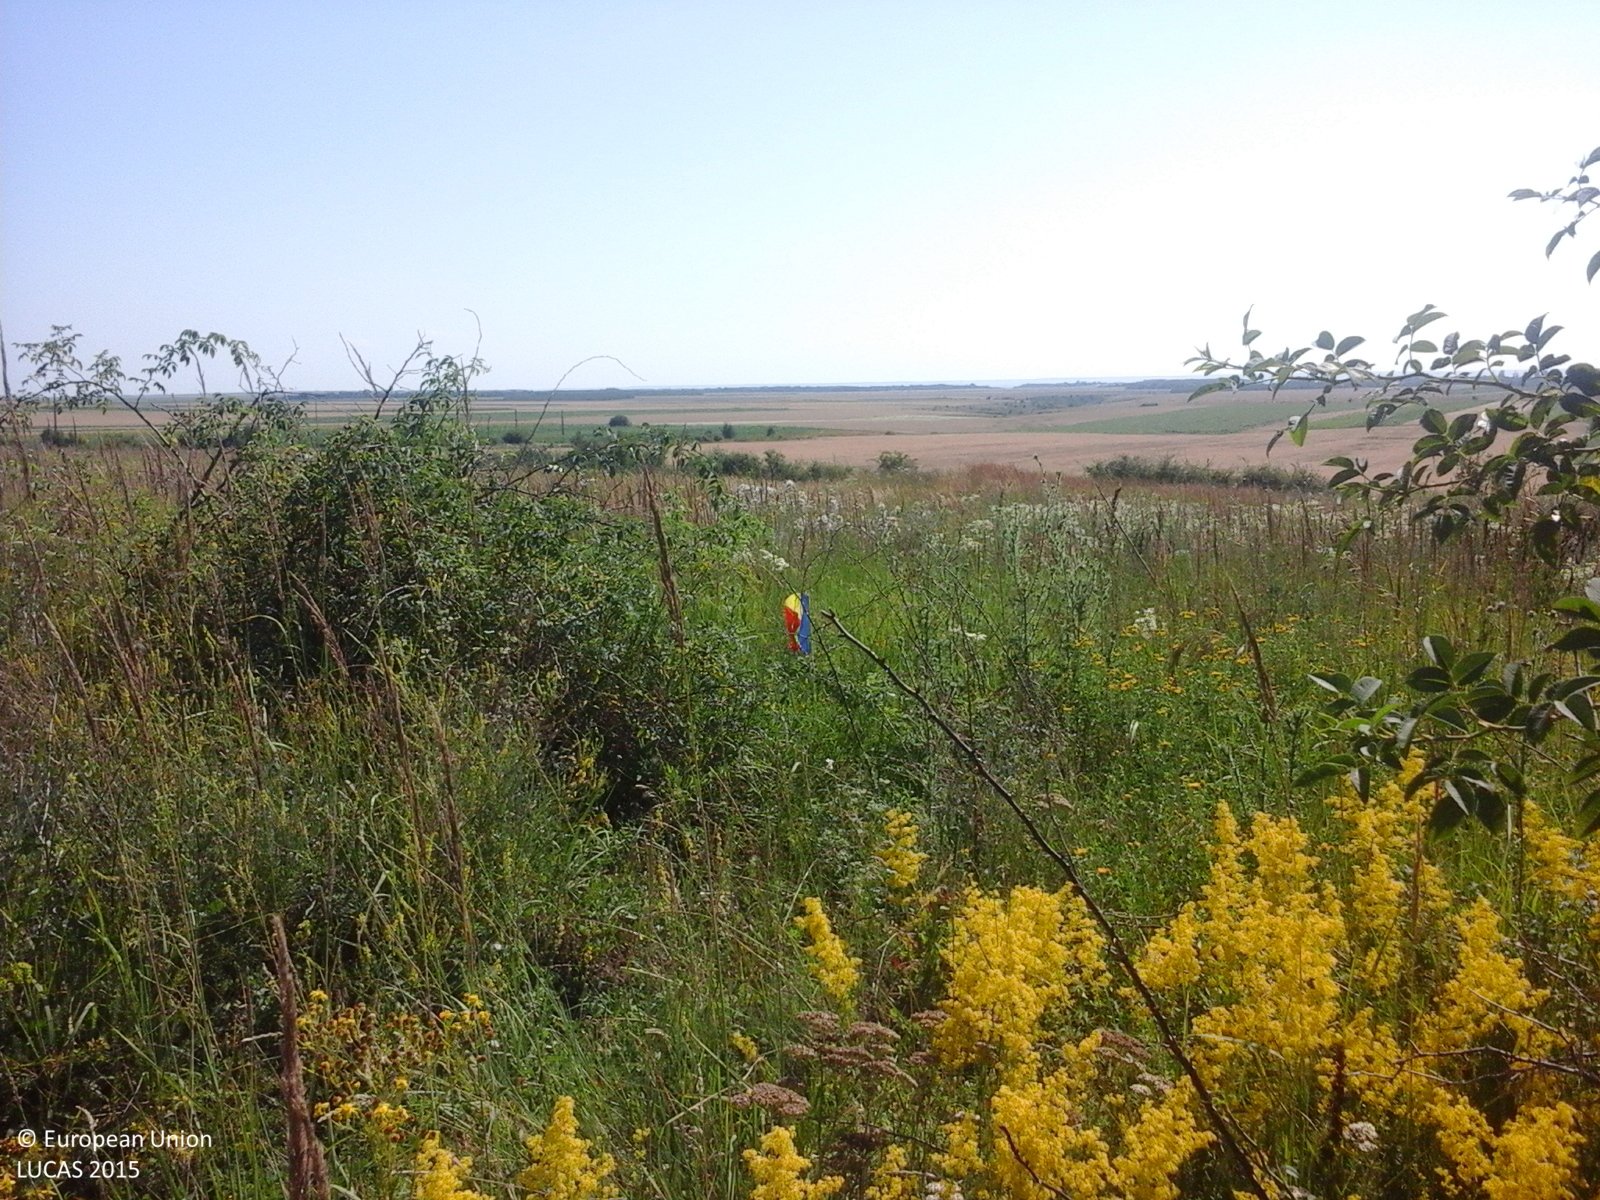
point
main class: Grassland
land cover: Grassland with sparse tree/shrub cover
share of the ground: > 75 %
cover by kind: herbaceous plants 85 %, shrubs 10 %, broadleaved forest trees 5 %
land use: Agriculture (excluding fallow land and kitchen gardens)
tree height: < 5 m
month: July
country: RO
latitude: 44.5678
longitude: 24.3861
